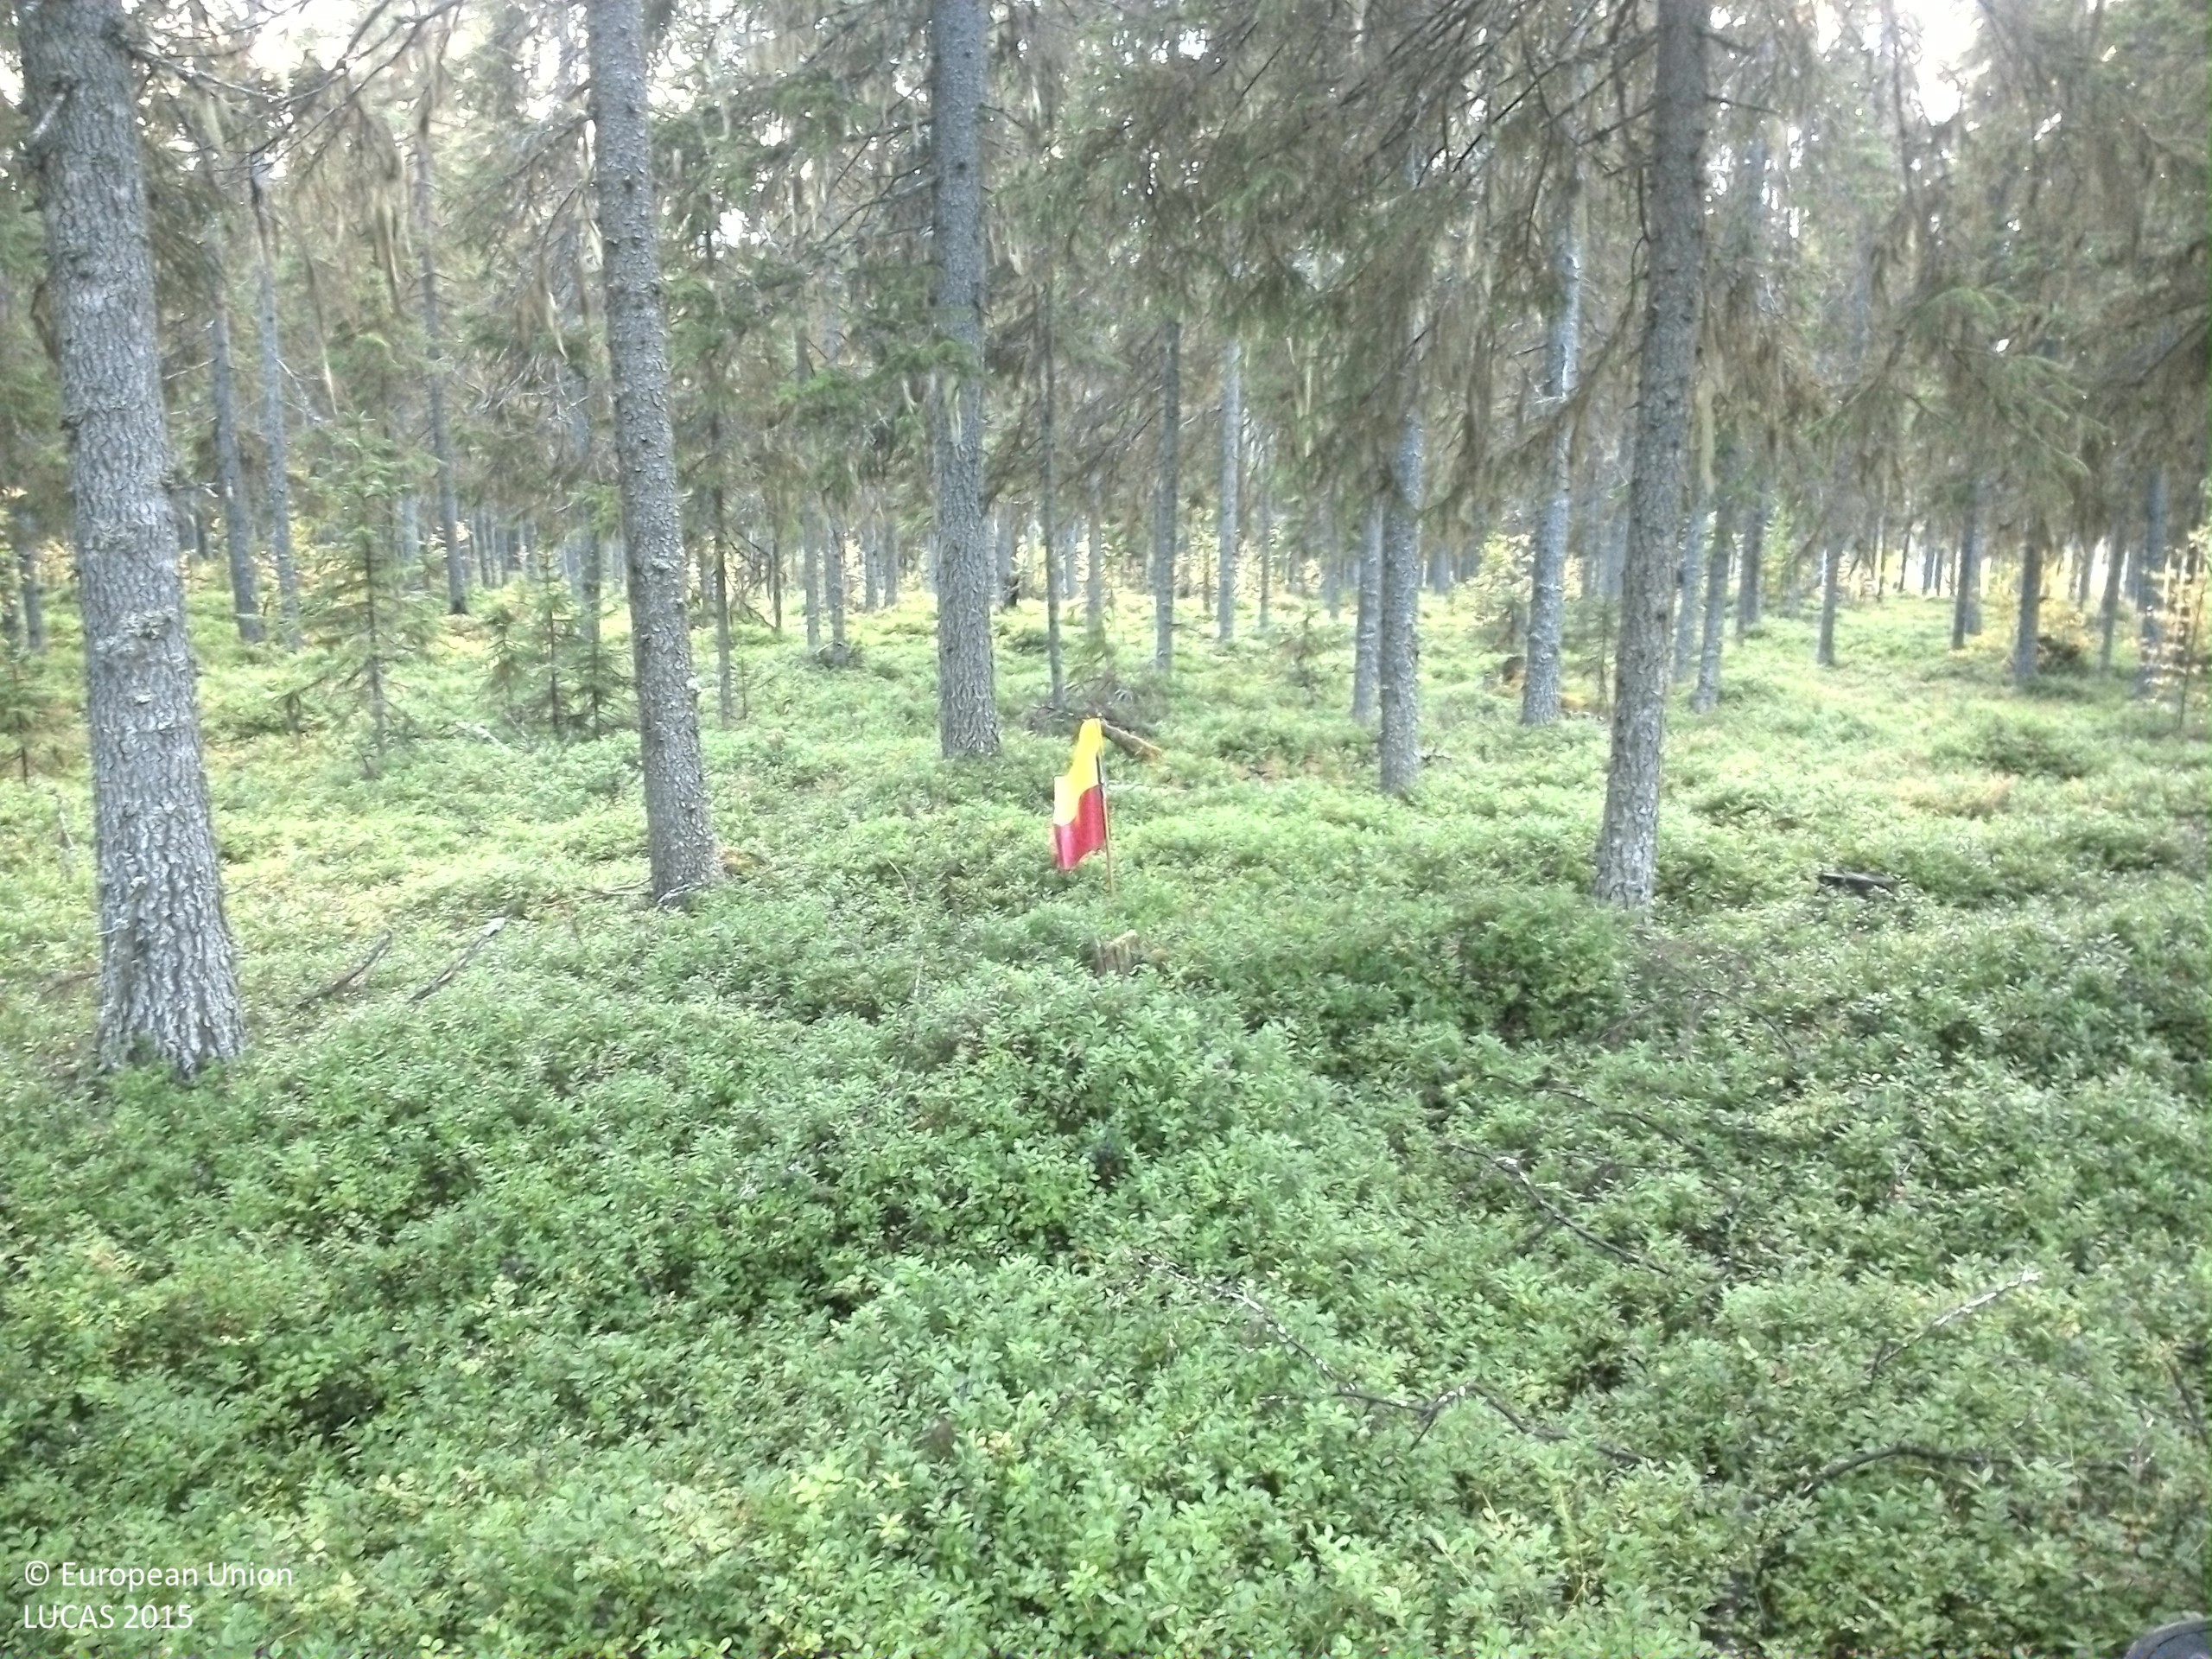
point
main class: Woodland
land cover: Spruce dominated coniferous woodland
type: boreal forest
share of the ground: 25 - 50 %
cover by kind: shrubs 50 %, coniferous forest trees 40 %, broadleaved forest trees 5 %, lichens and mosses 5 %
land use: Forestry
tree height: > 5 m
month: September
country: SE
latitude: 63.7683
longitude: 16.2385
